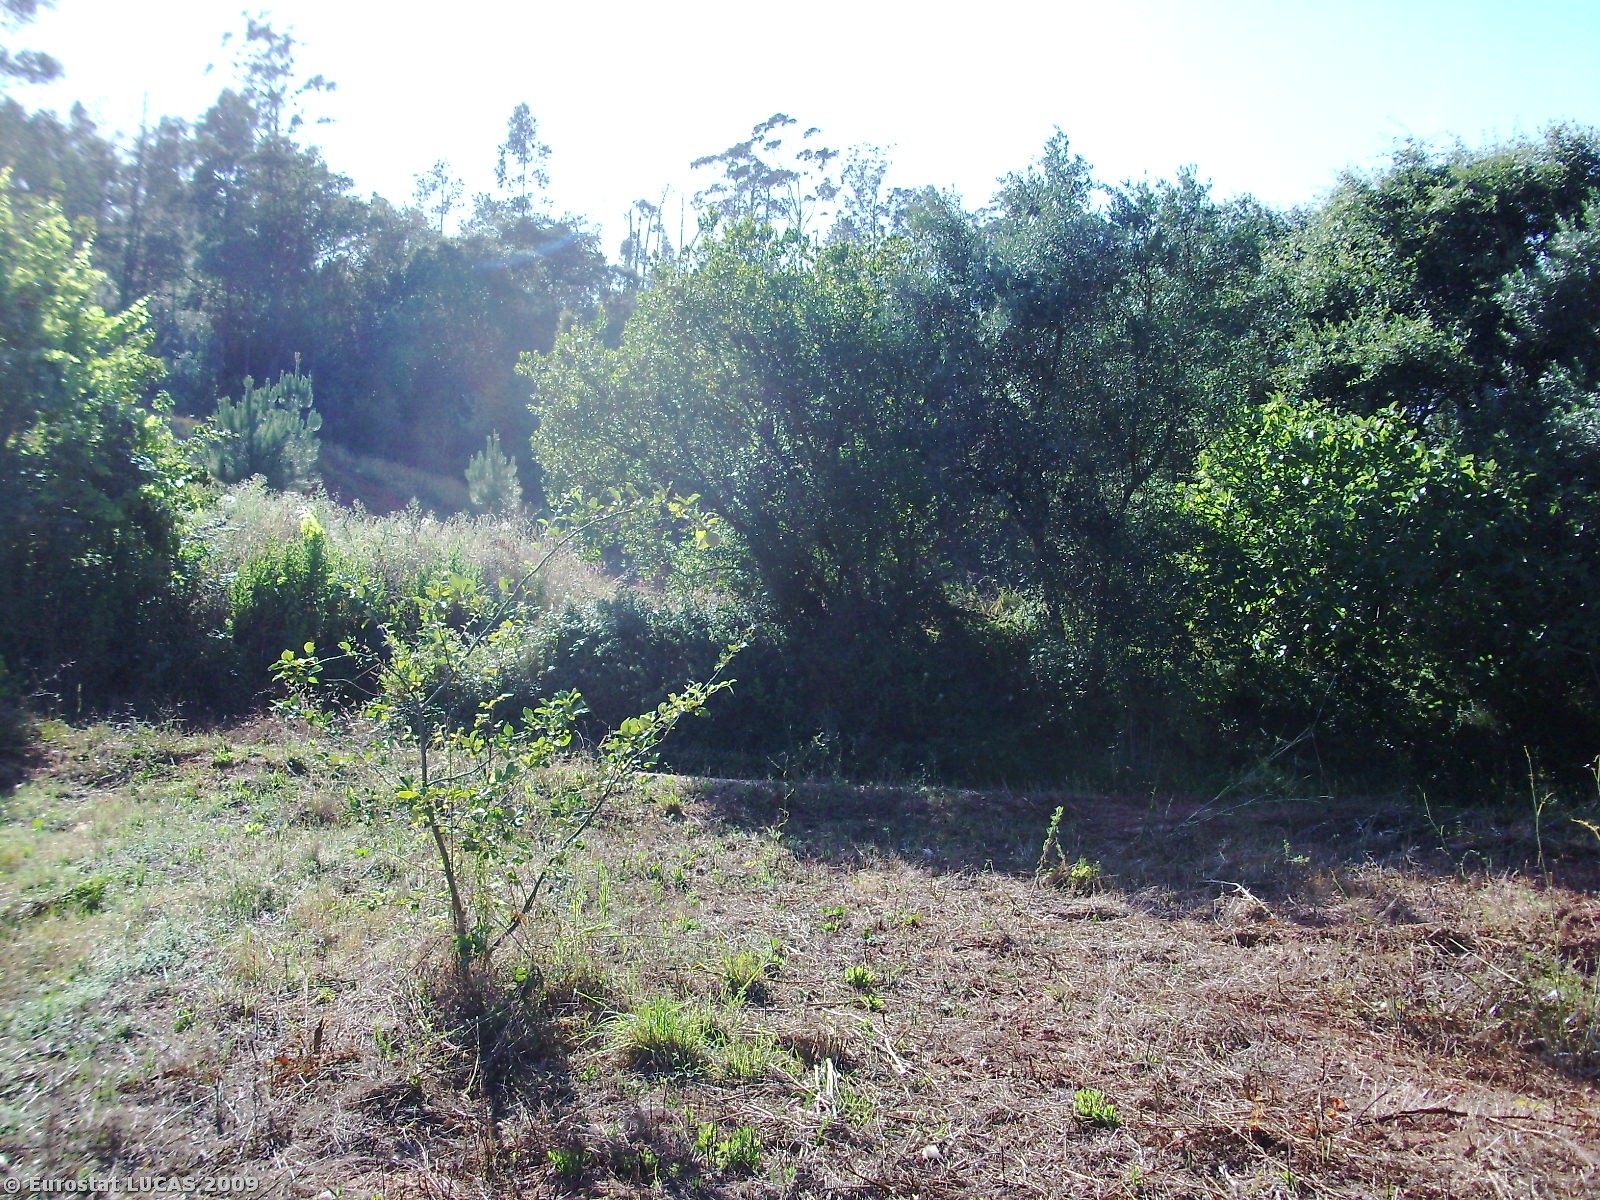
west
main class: Grassland
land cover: Spontaneously vegetated surfaces
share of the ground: > 75 %
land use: Fallow land
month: July
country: PT
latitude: 39.5057
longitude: -8.9850
